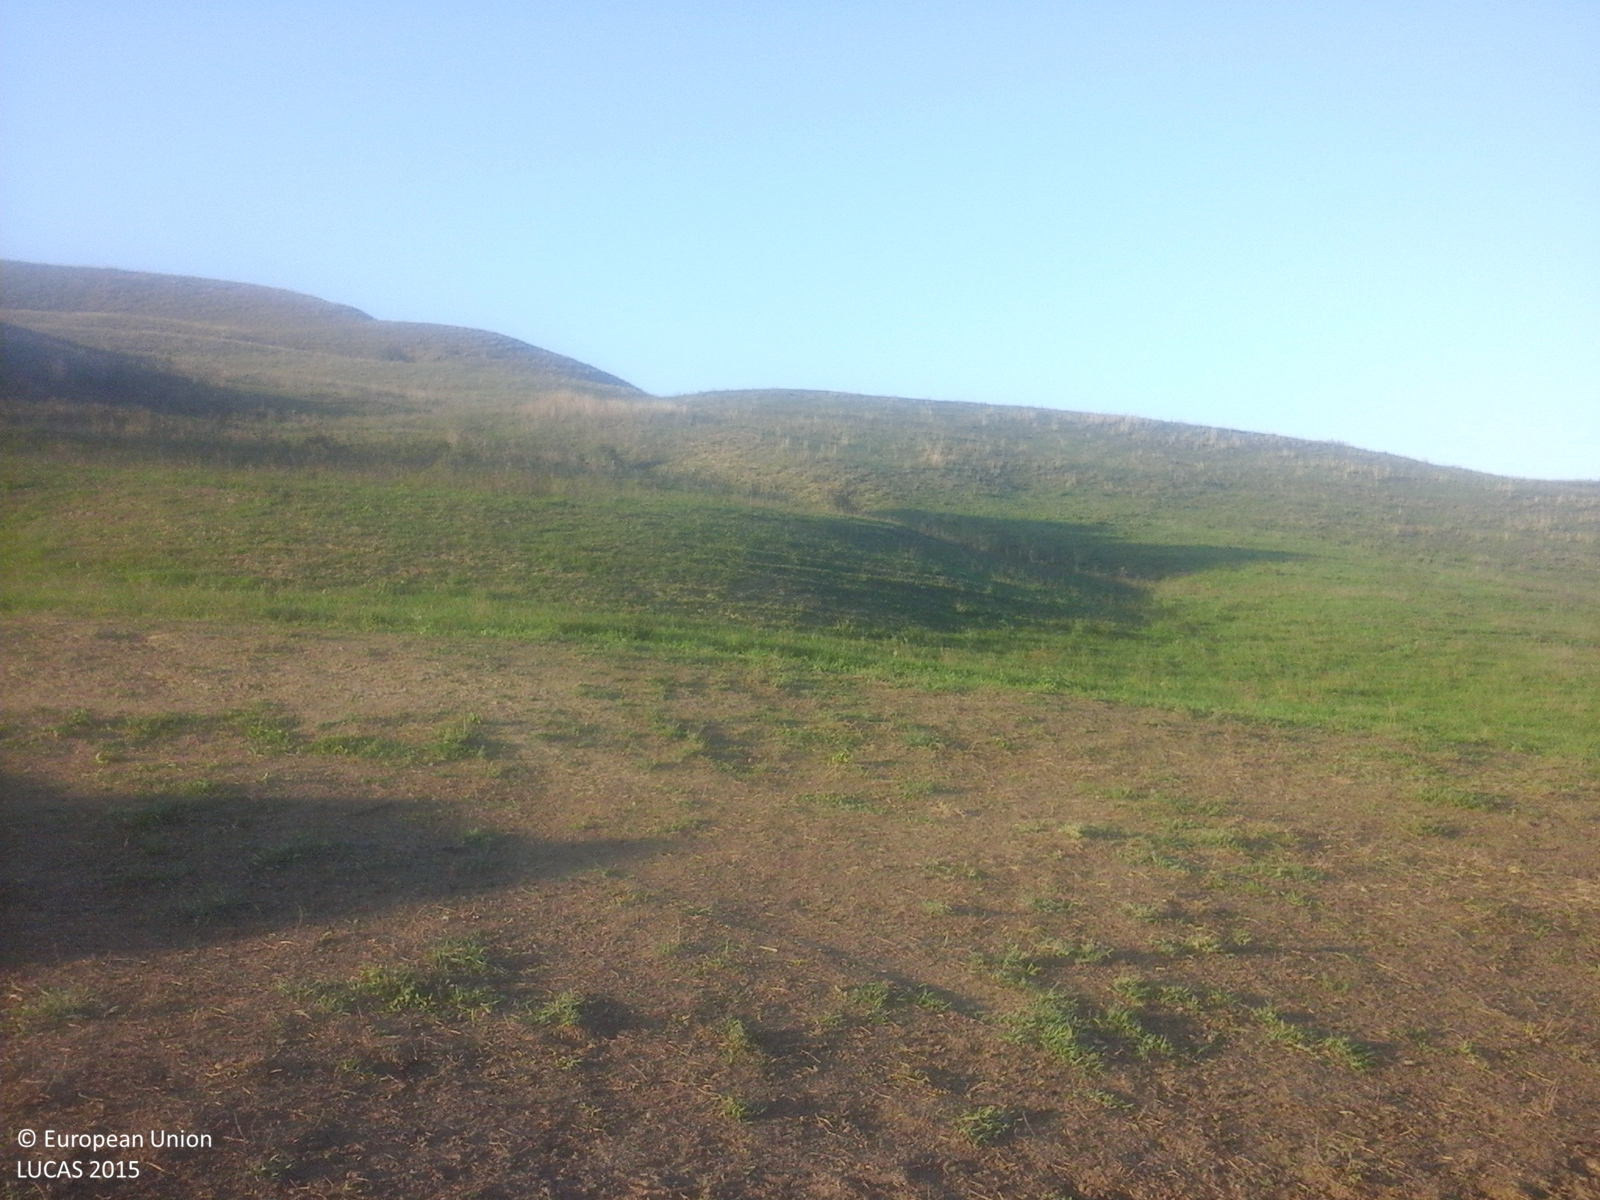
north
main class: Grassland
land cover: Grassland without tree/shrub cover
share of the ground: > 75 %
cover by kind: herbaceous plants 100 %
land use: Agriculture (excluding fallow land and kitchen gardens)
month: October
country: RO
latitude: 45.9243
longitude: 24.0914
